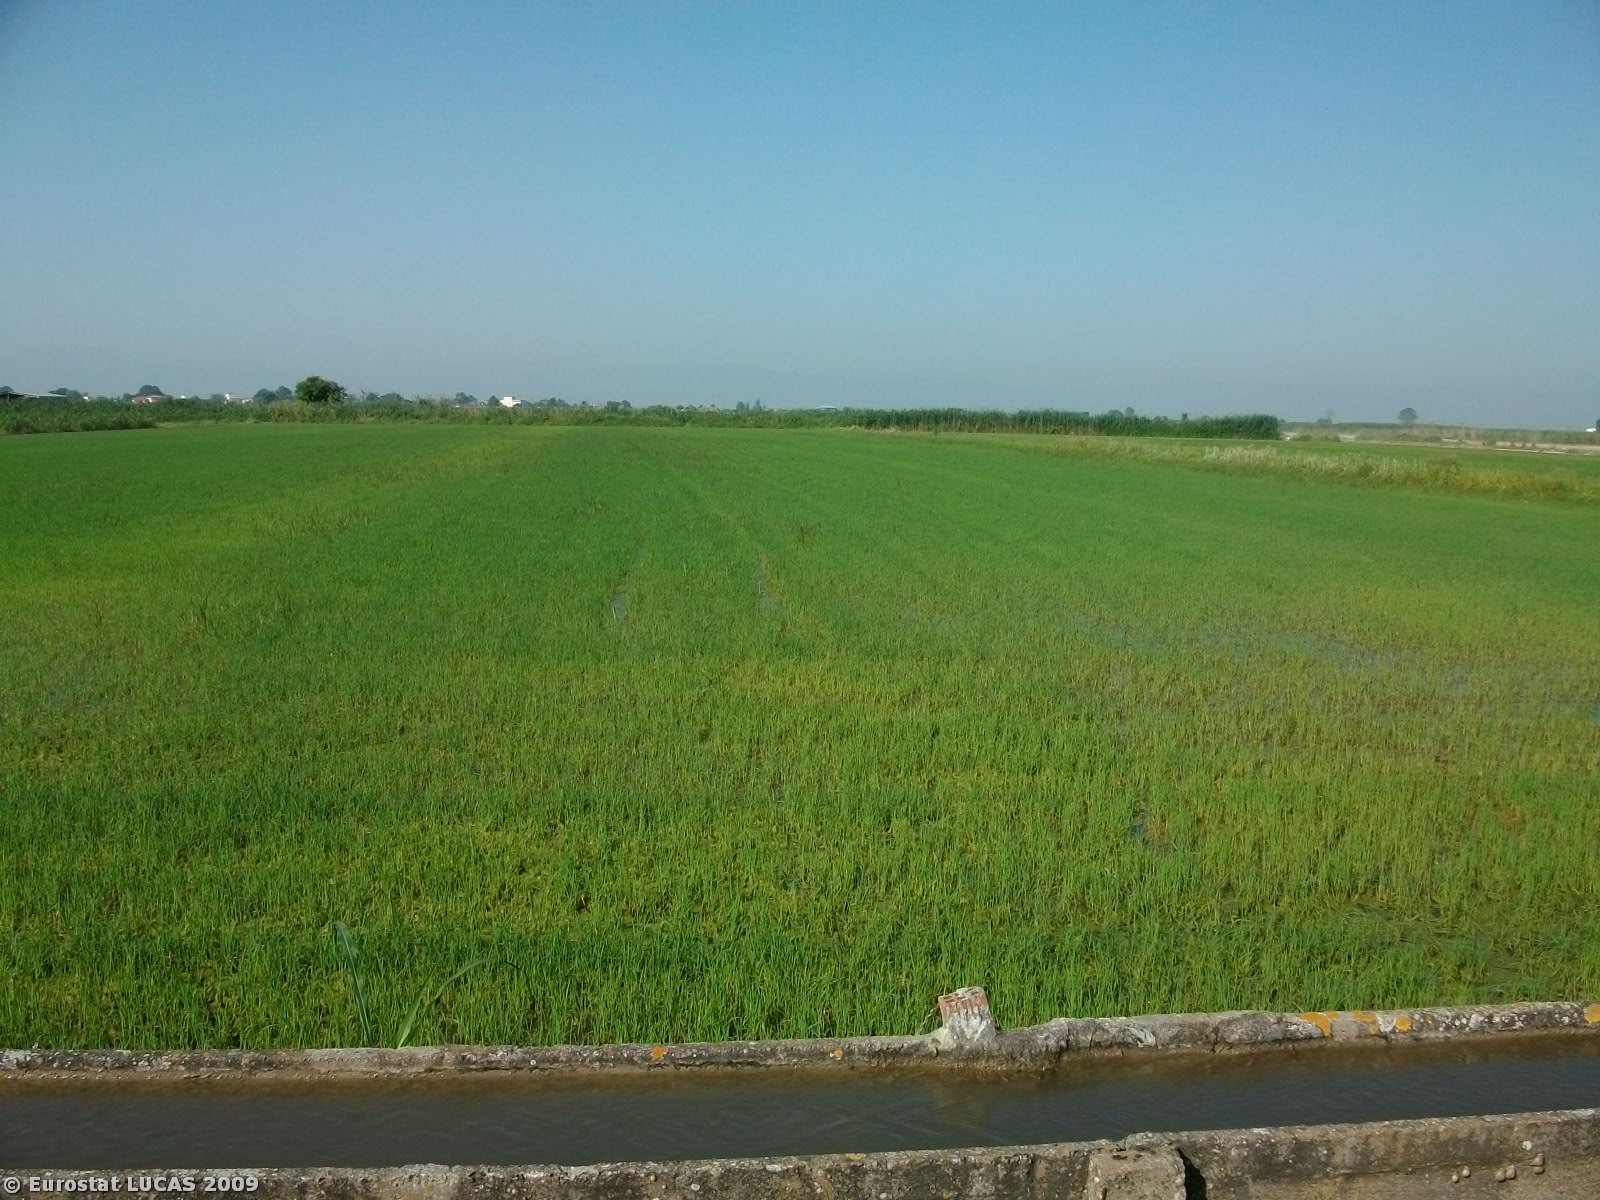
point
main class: Cropland
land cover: Rice
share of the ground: > 75 %
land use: Agriculture (excluding fallow land and kitchen gardens)
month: June
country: GR
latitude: 40.6283
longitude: 22.6896
